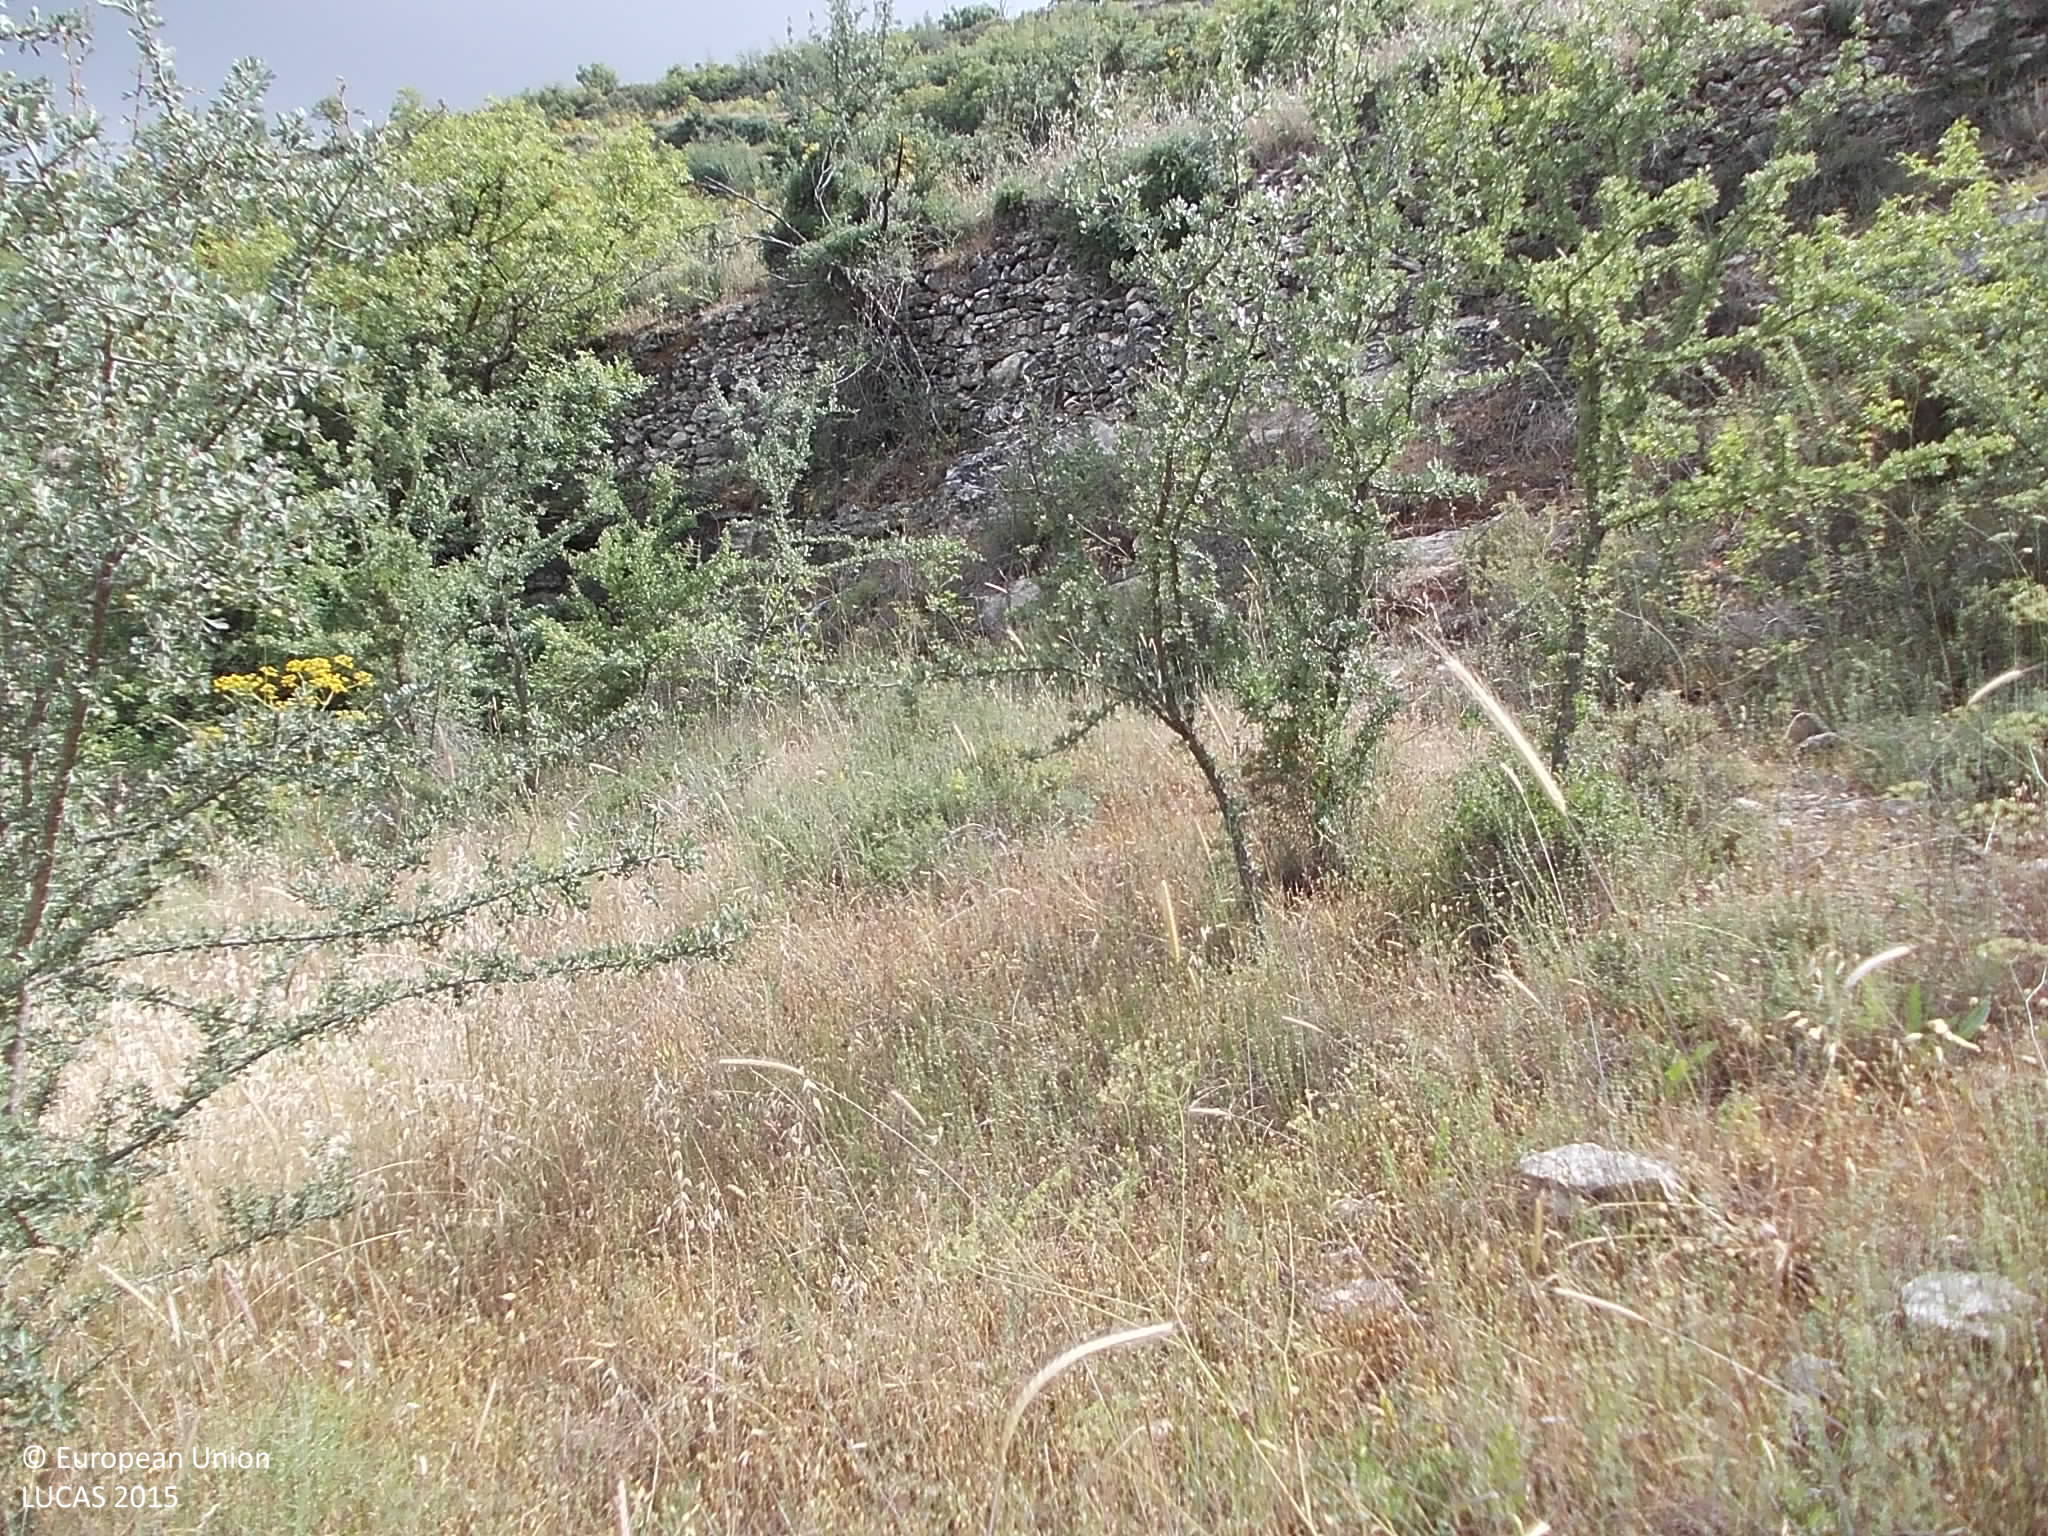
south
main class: Grassland
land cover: Grassland with sparse tree/shrub cover
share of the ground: > 75 %
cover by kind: herbaceous plants 85 %, broadleaved forest trees 5 %, shrubs 5 %, unconsolidated bare surface 5 %
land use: Abandoned areas
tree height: < 5 m
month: May
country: CY
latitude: 34.8078
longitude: 32.7983
